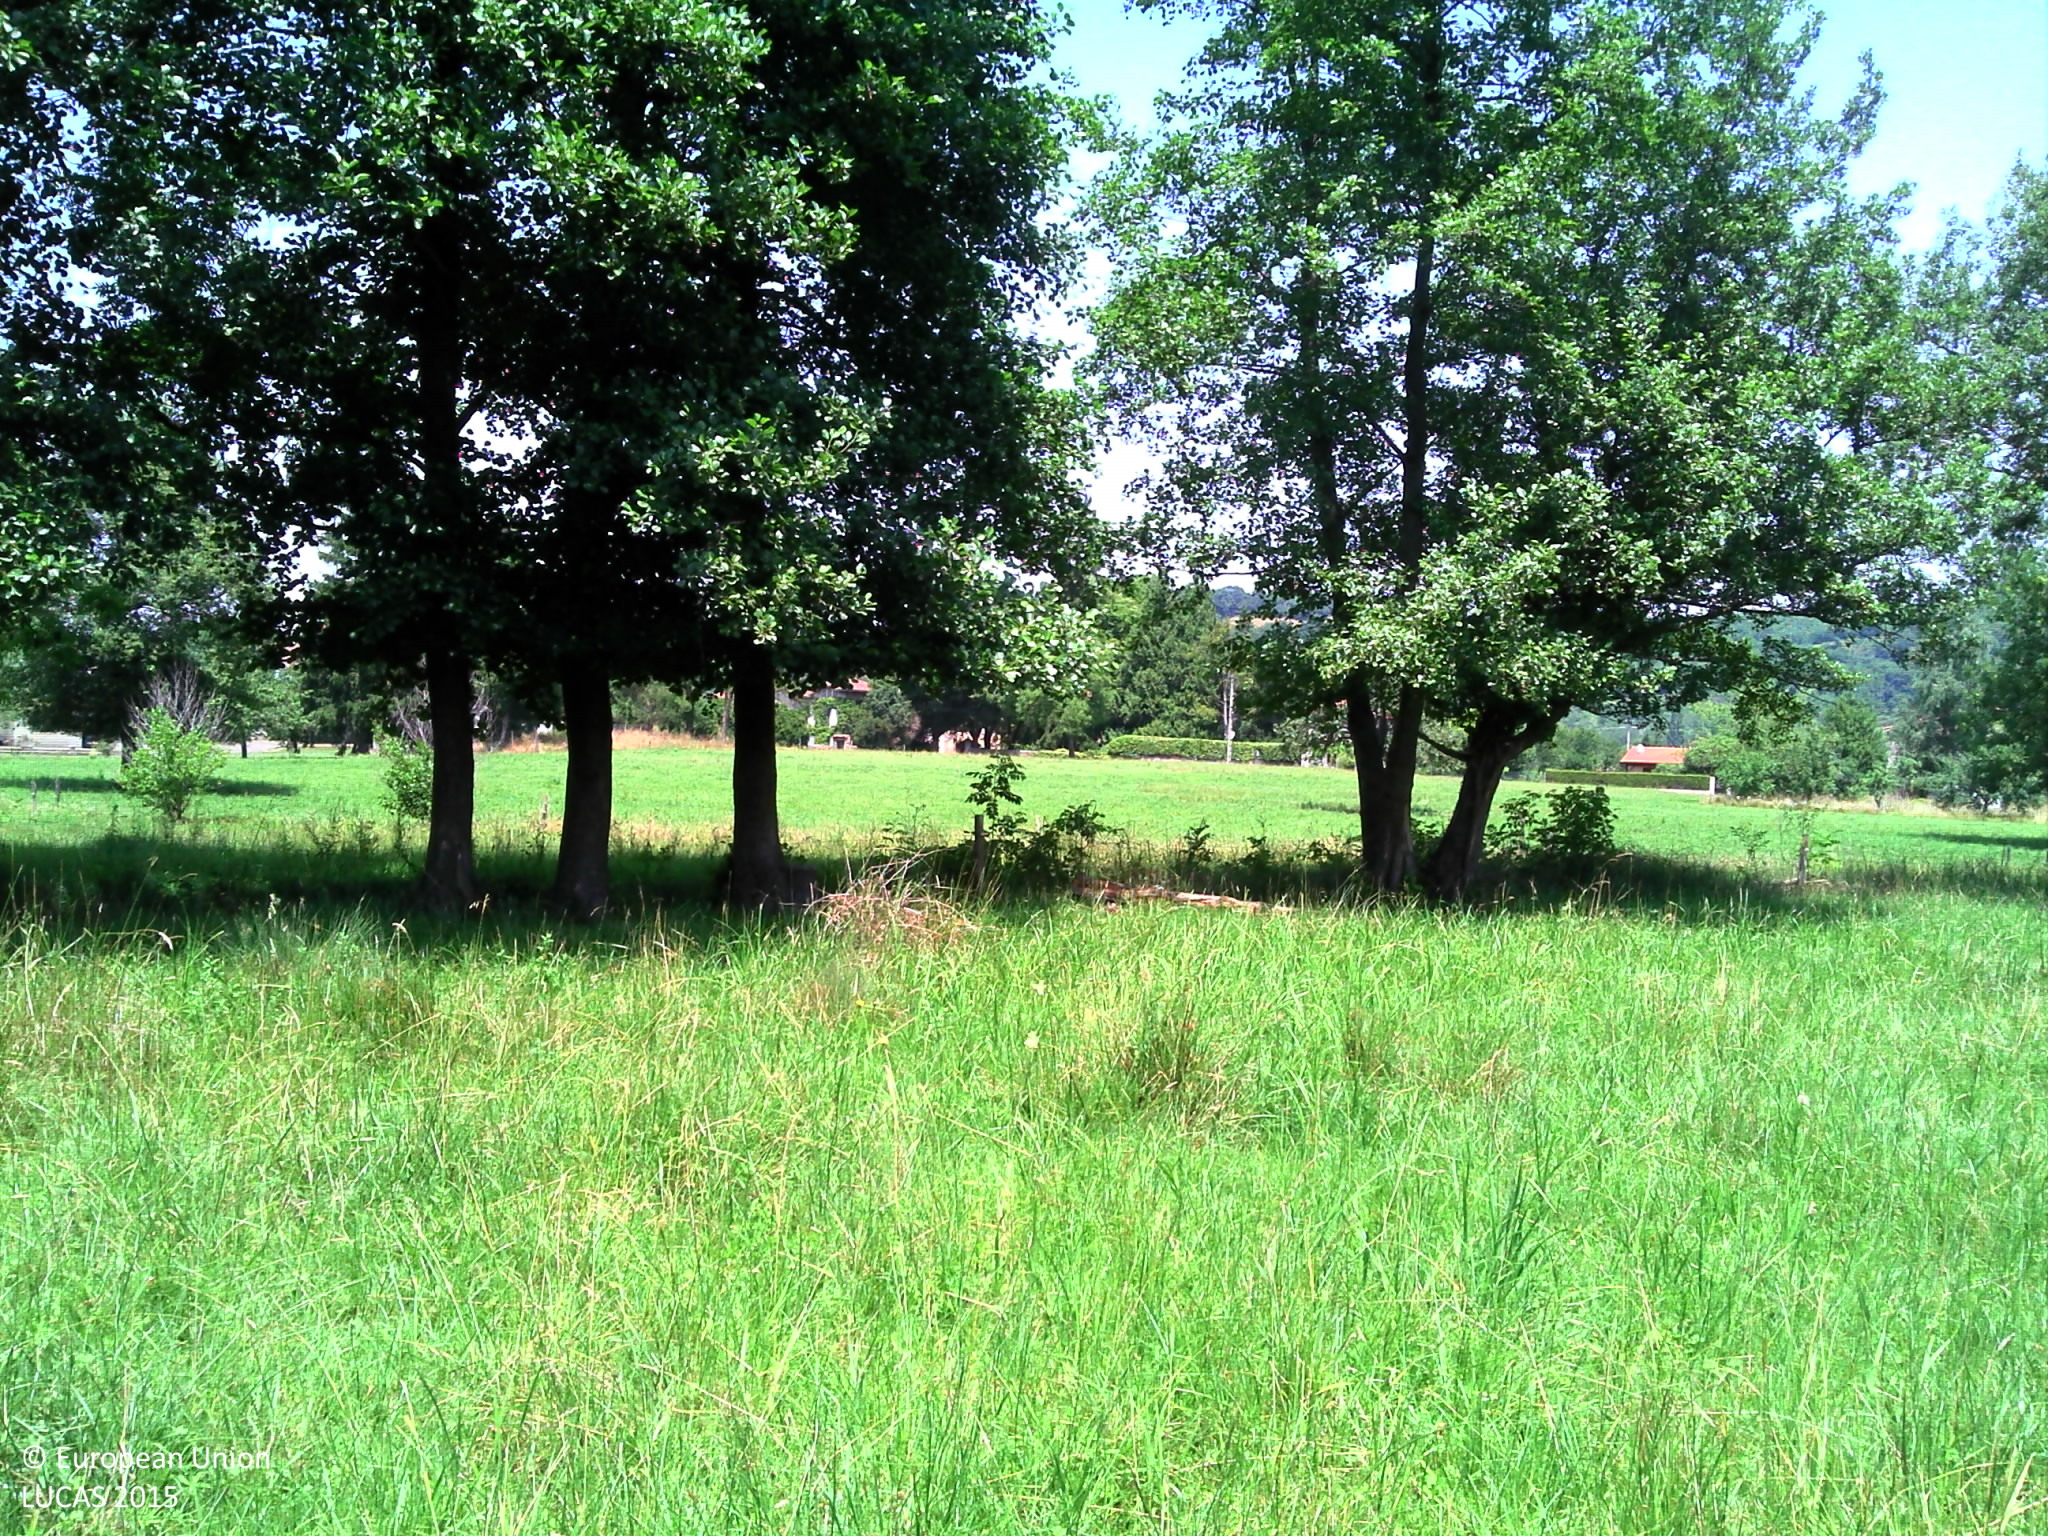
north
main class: Grassland
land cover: Grassland without tree/shrub cover
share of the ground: > 75 %
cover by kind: herbaceous plants 100 %
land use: Agriculture (excluding fallow land and kitchen gardens)
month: July
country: FR
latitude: 43.0247
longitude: 1.1074
